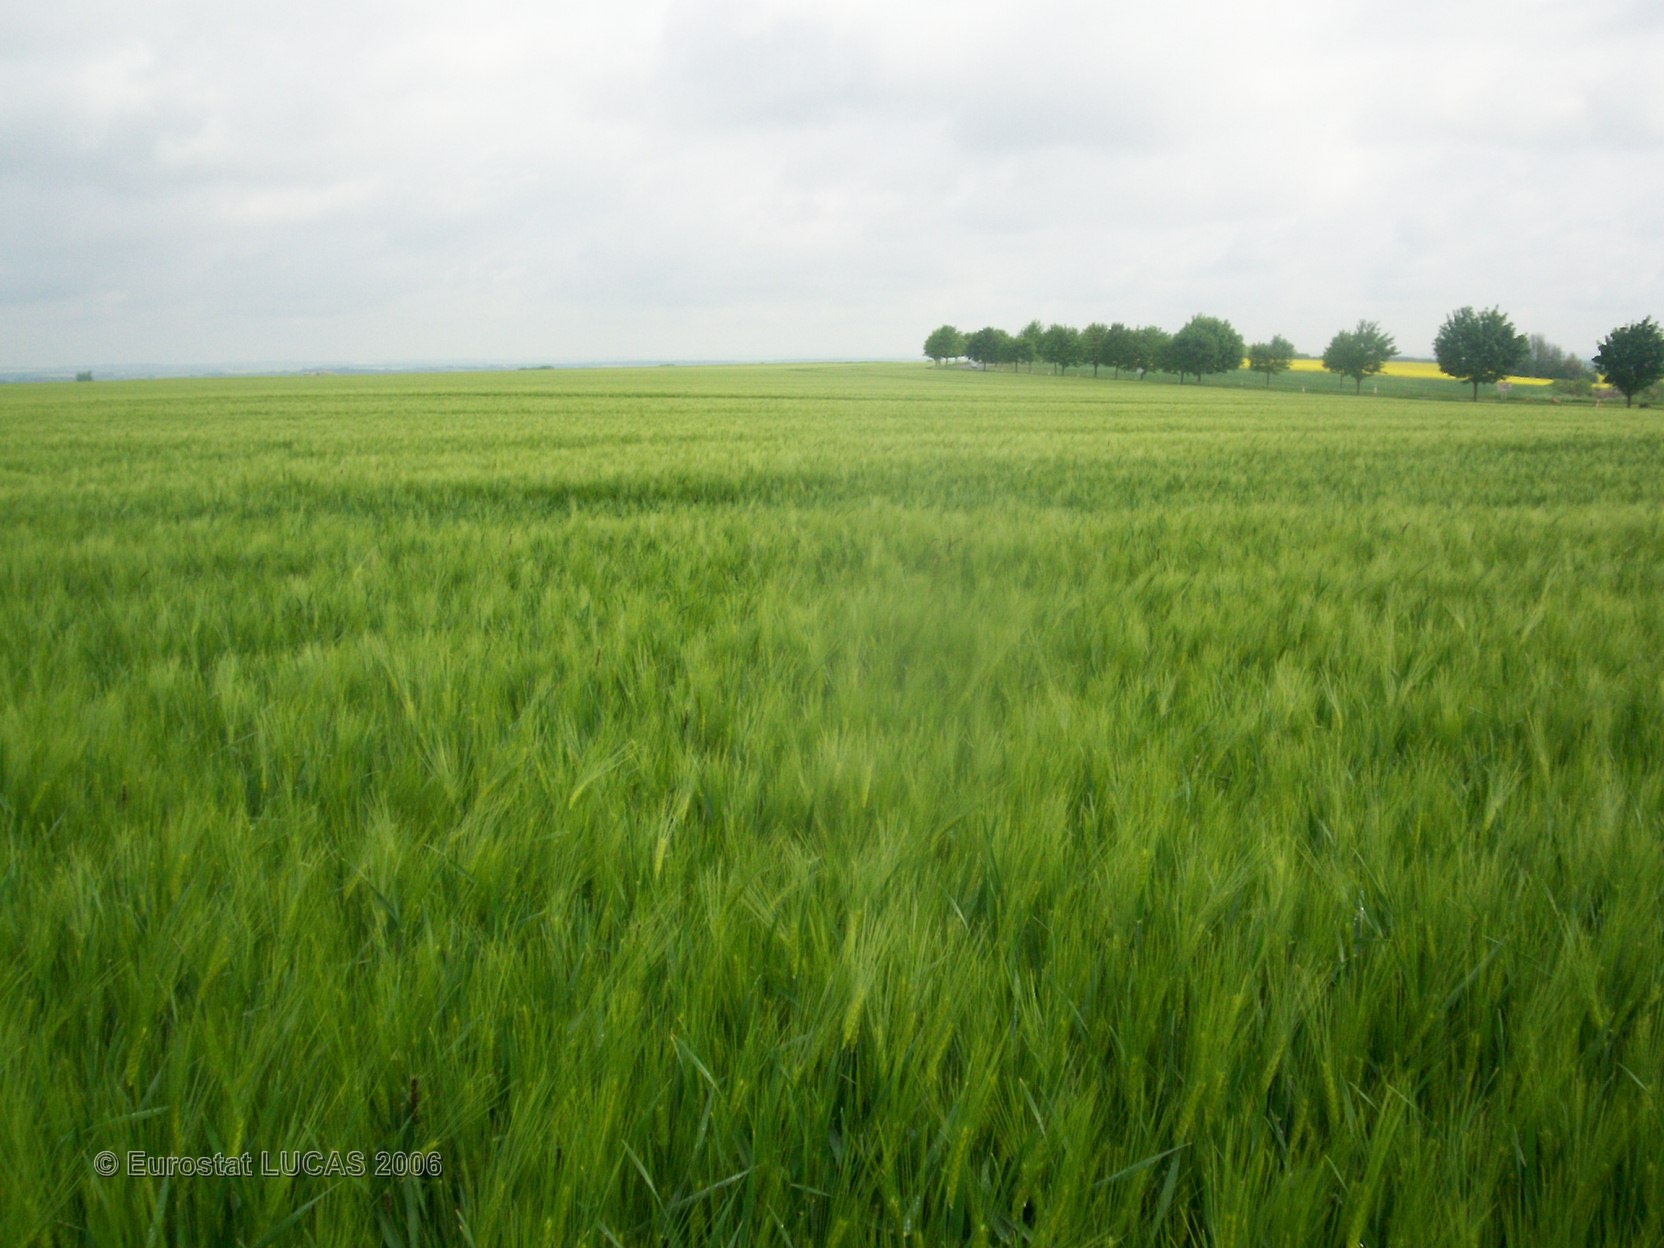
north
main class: Cropland
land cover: Barley
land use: Agriculture (excluding fallow land and kitchen gardens)
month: May
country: FR
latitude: 49.1012
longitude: 5.8766
